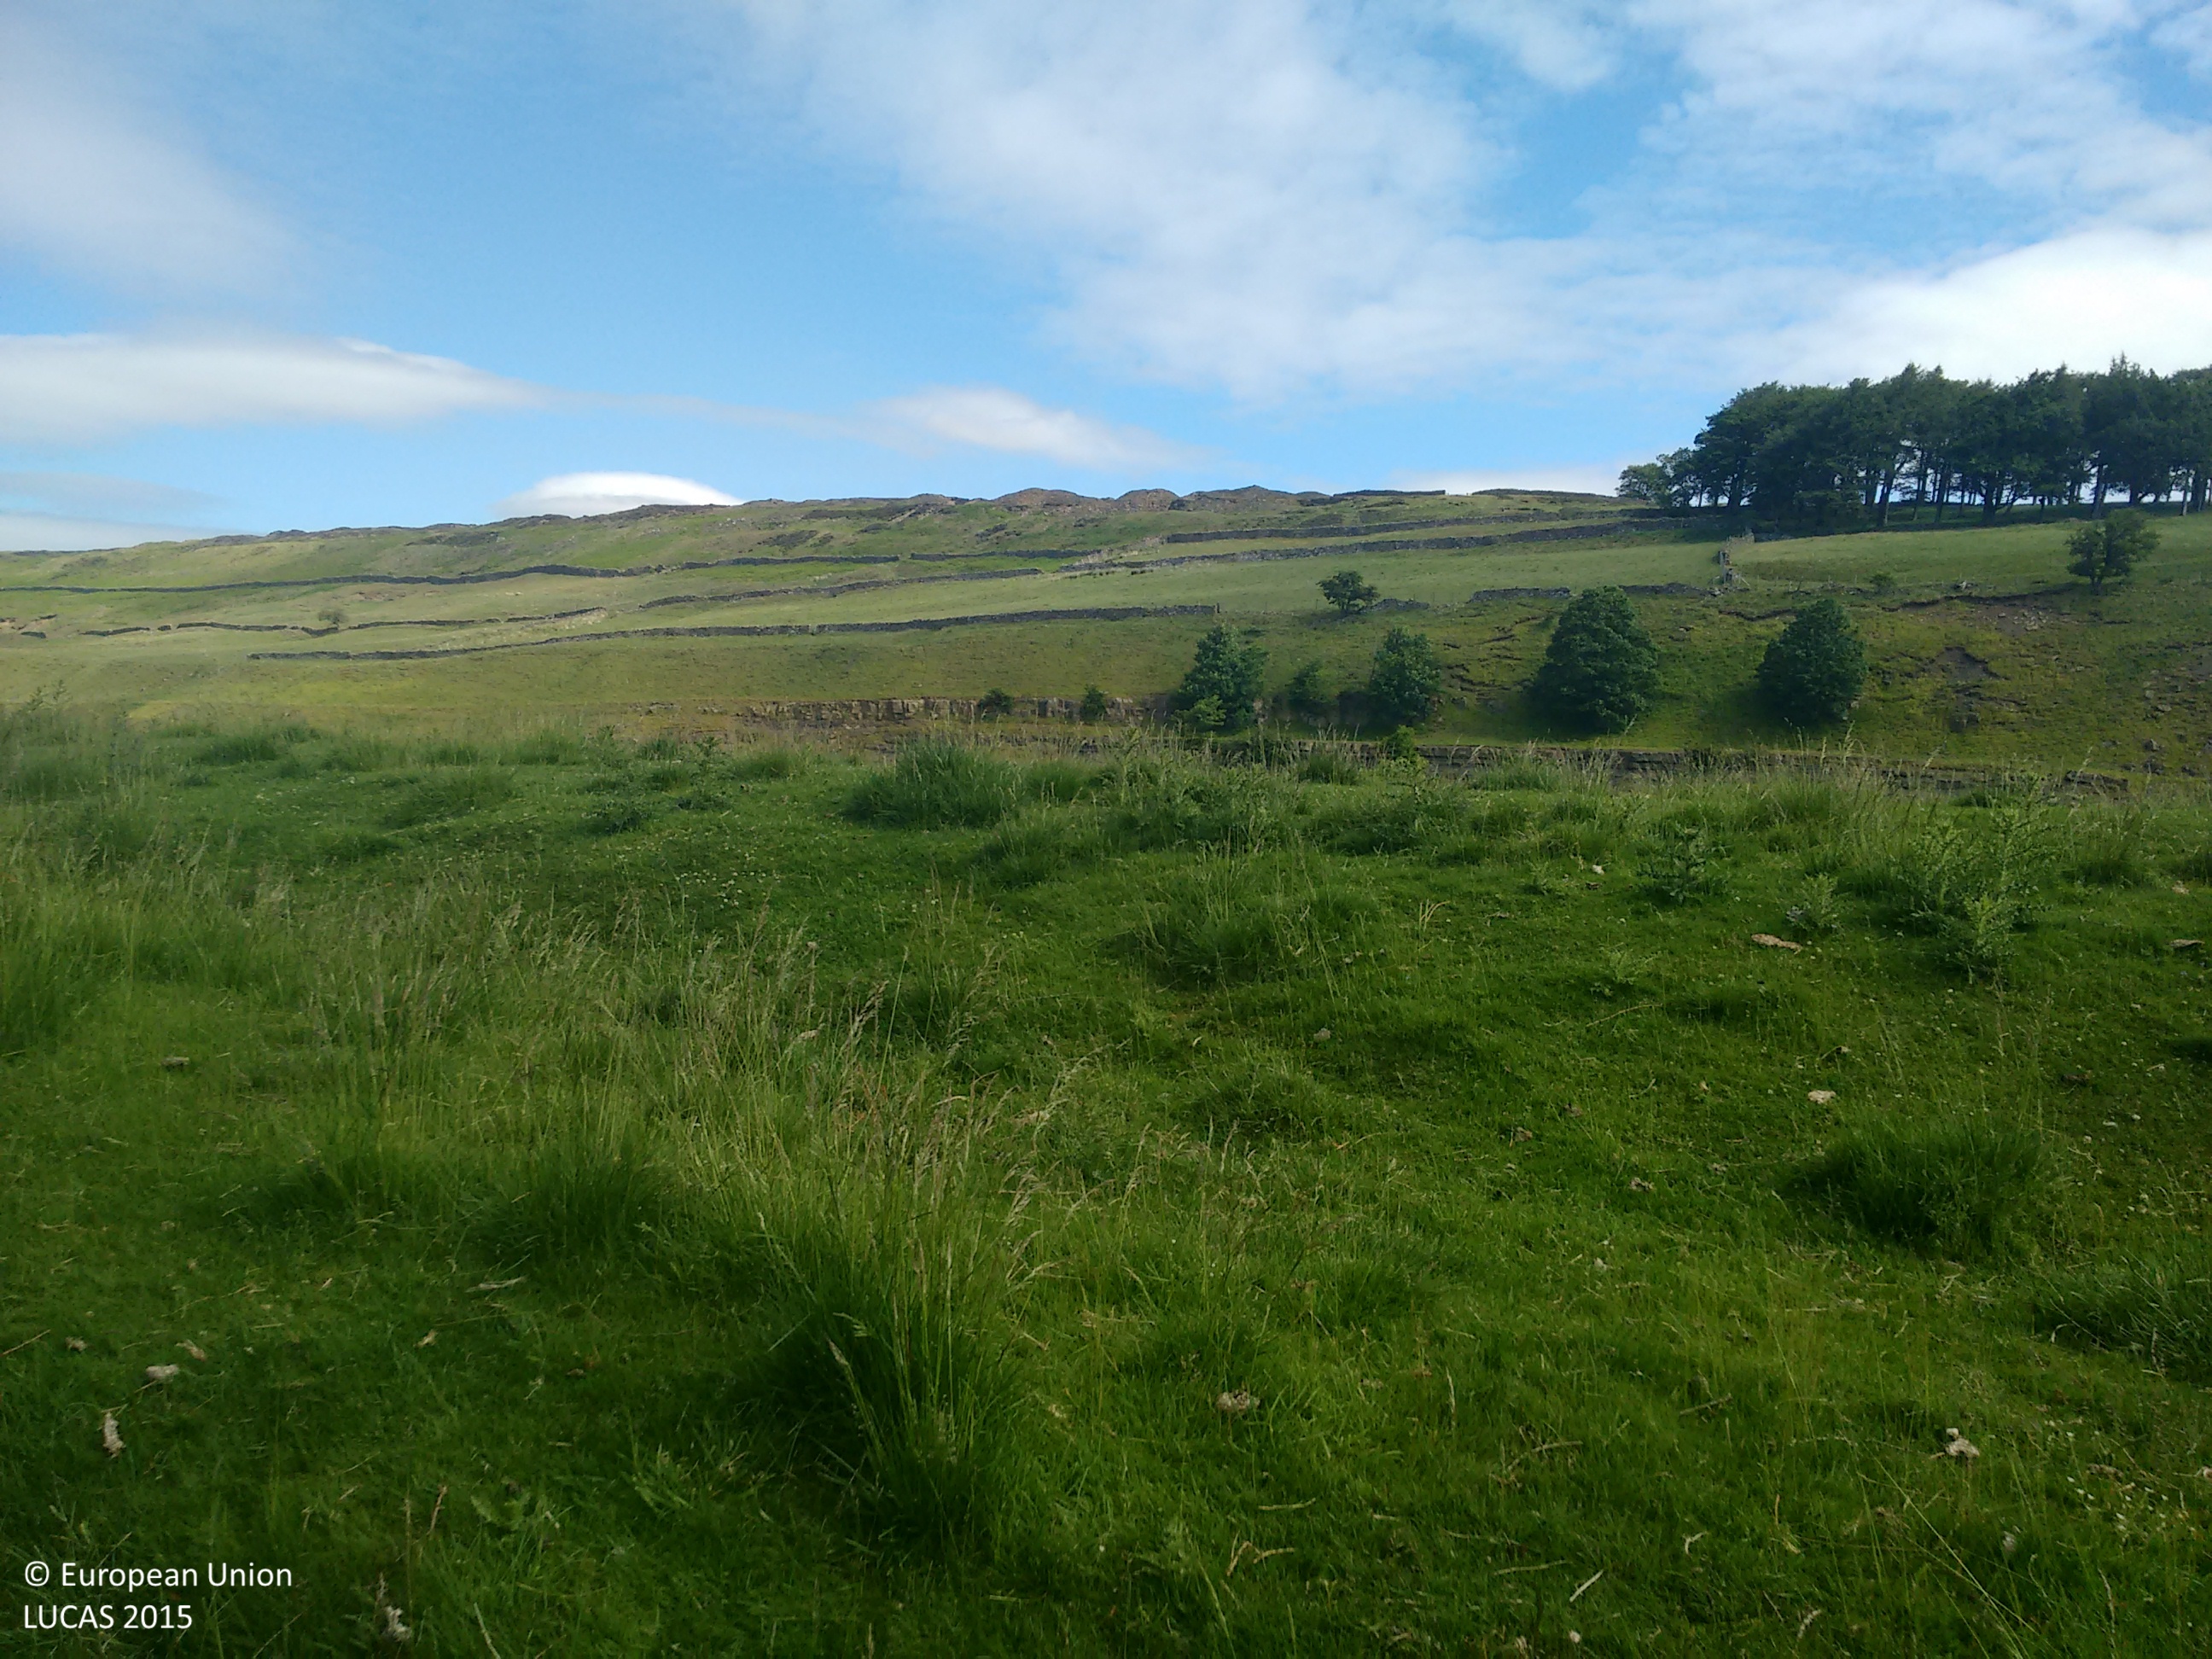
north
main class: Grassland
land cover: Grassland without tree/shrub cover
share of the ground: > 75 %
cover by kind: herbaceous plants 100 %
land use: Agriculture (excluding fallow land and kitchen gardens)
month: June
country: GB
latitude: 54.7486
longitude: -2.0023
